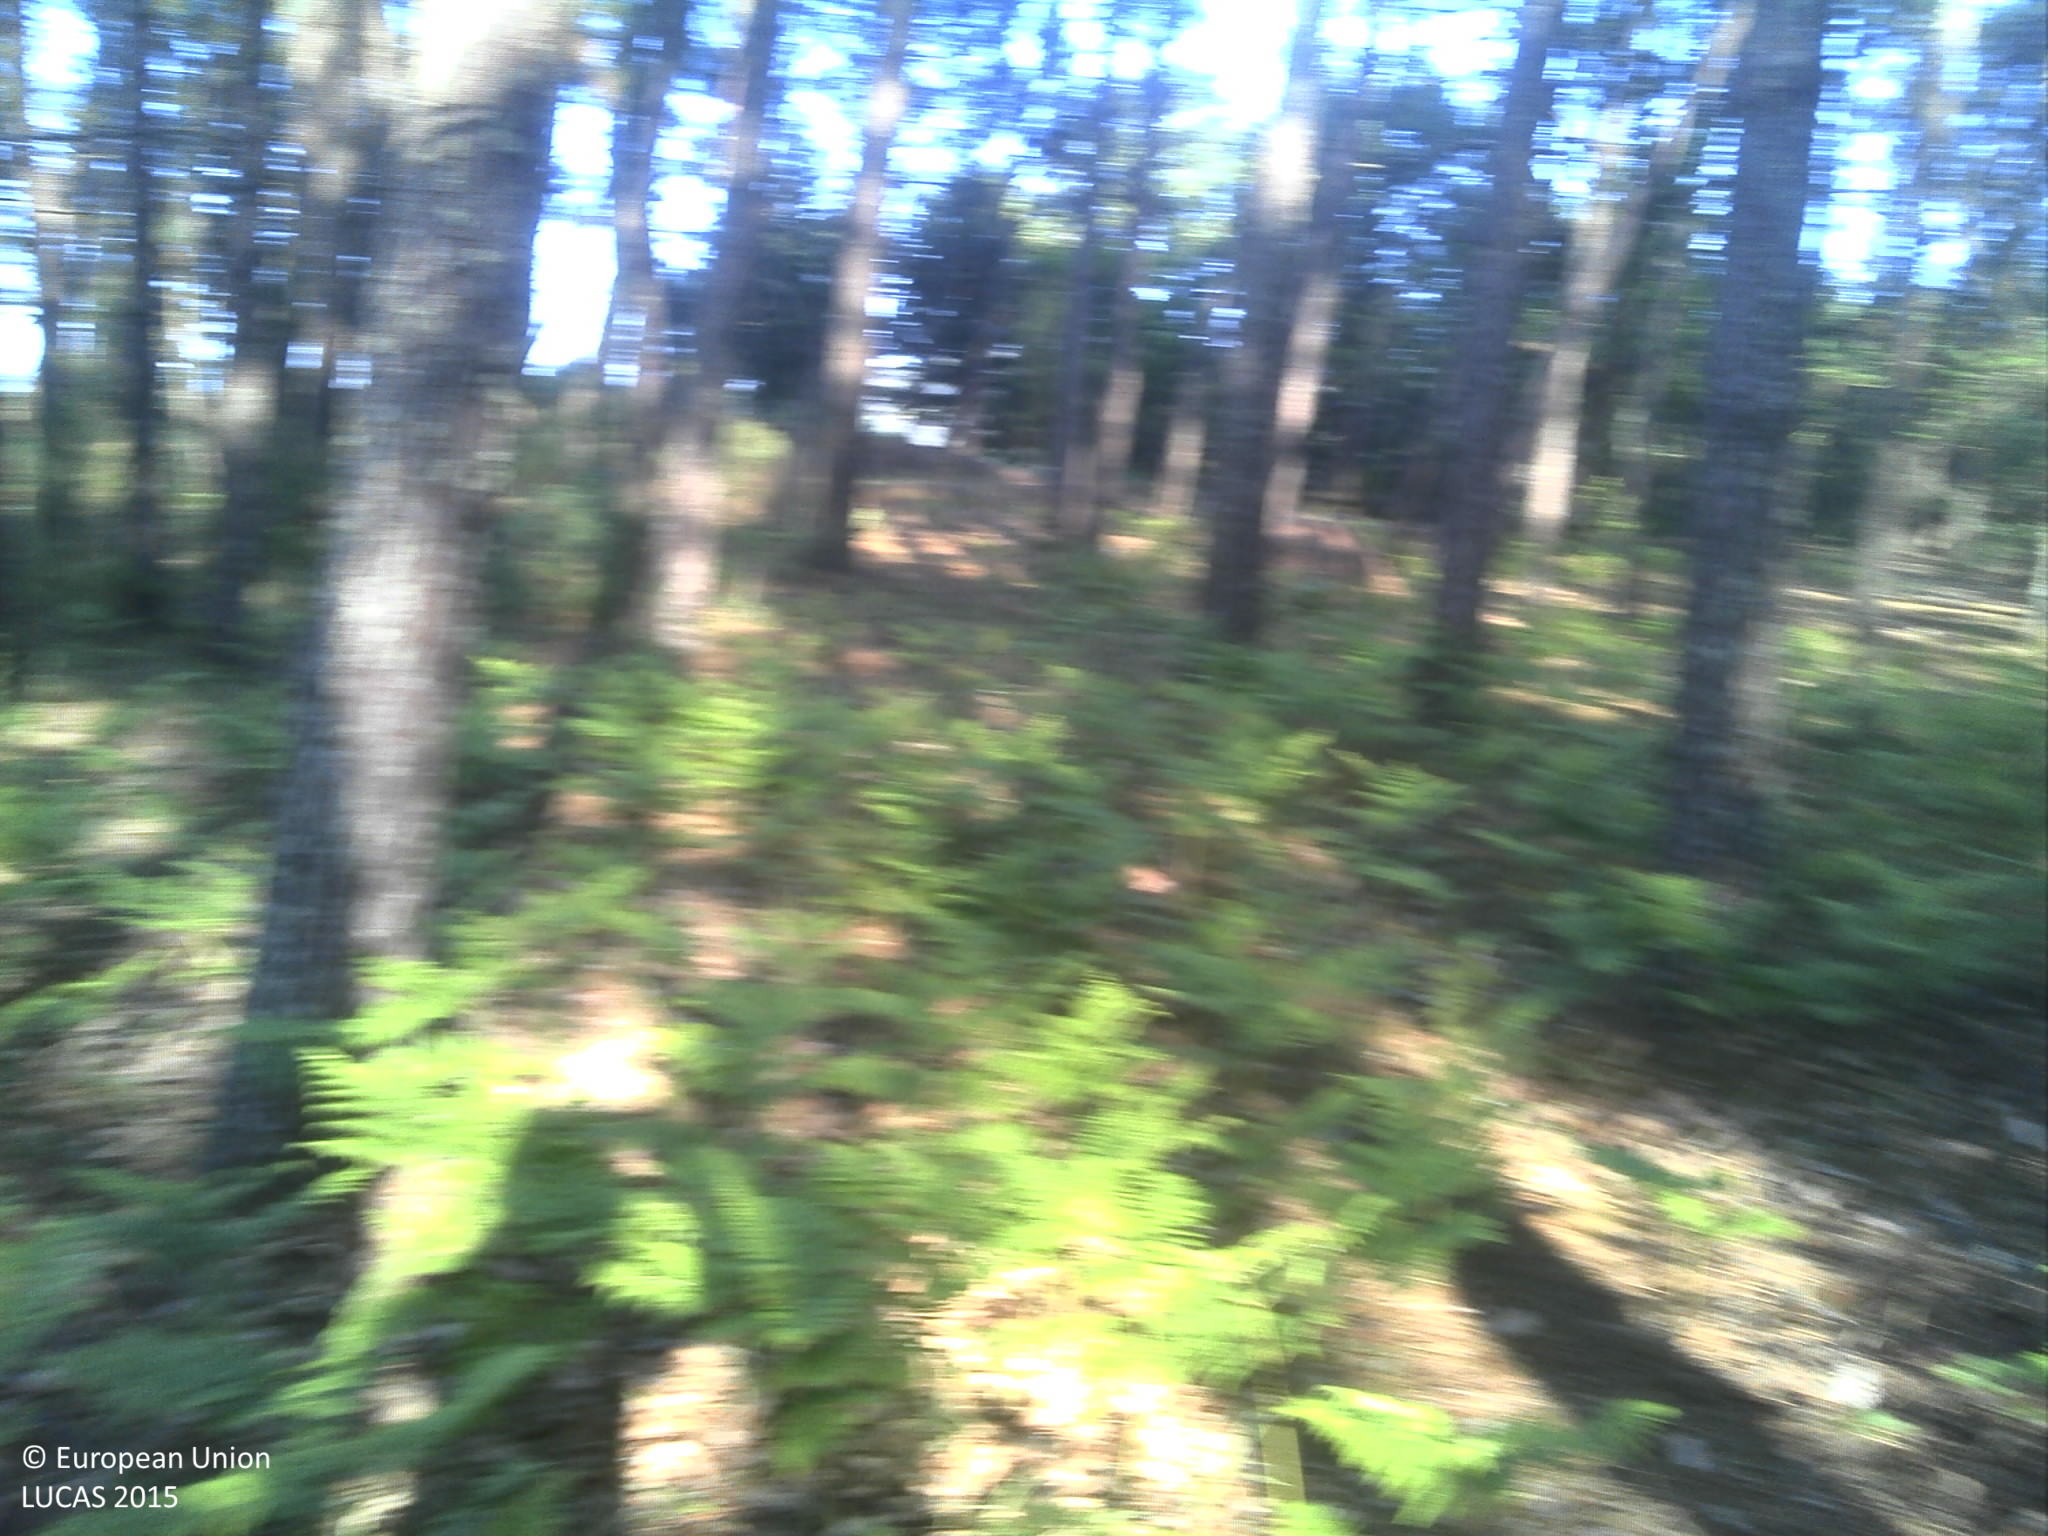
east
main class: Woodland
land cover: Pine dominated coniferous woodland
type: coniferous forest of the mediterranean region
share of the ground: 50 - 75 %
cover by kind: coniferous forest trees 100 %
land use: Forestry
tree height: > 5 m
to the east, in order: Pine dominated coniferous woodland; Tracks; Pine dominated coniferous woodland; Broadleaved woodland; Inland fresh water bodies
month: May
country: PT
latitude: 40.6424
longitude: -7.7749
